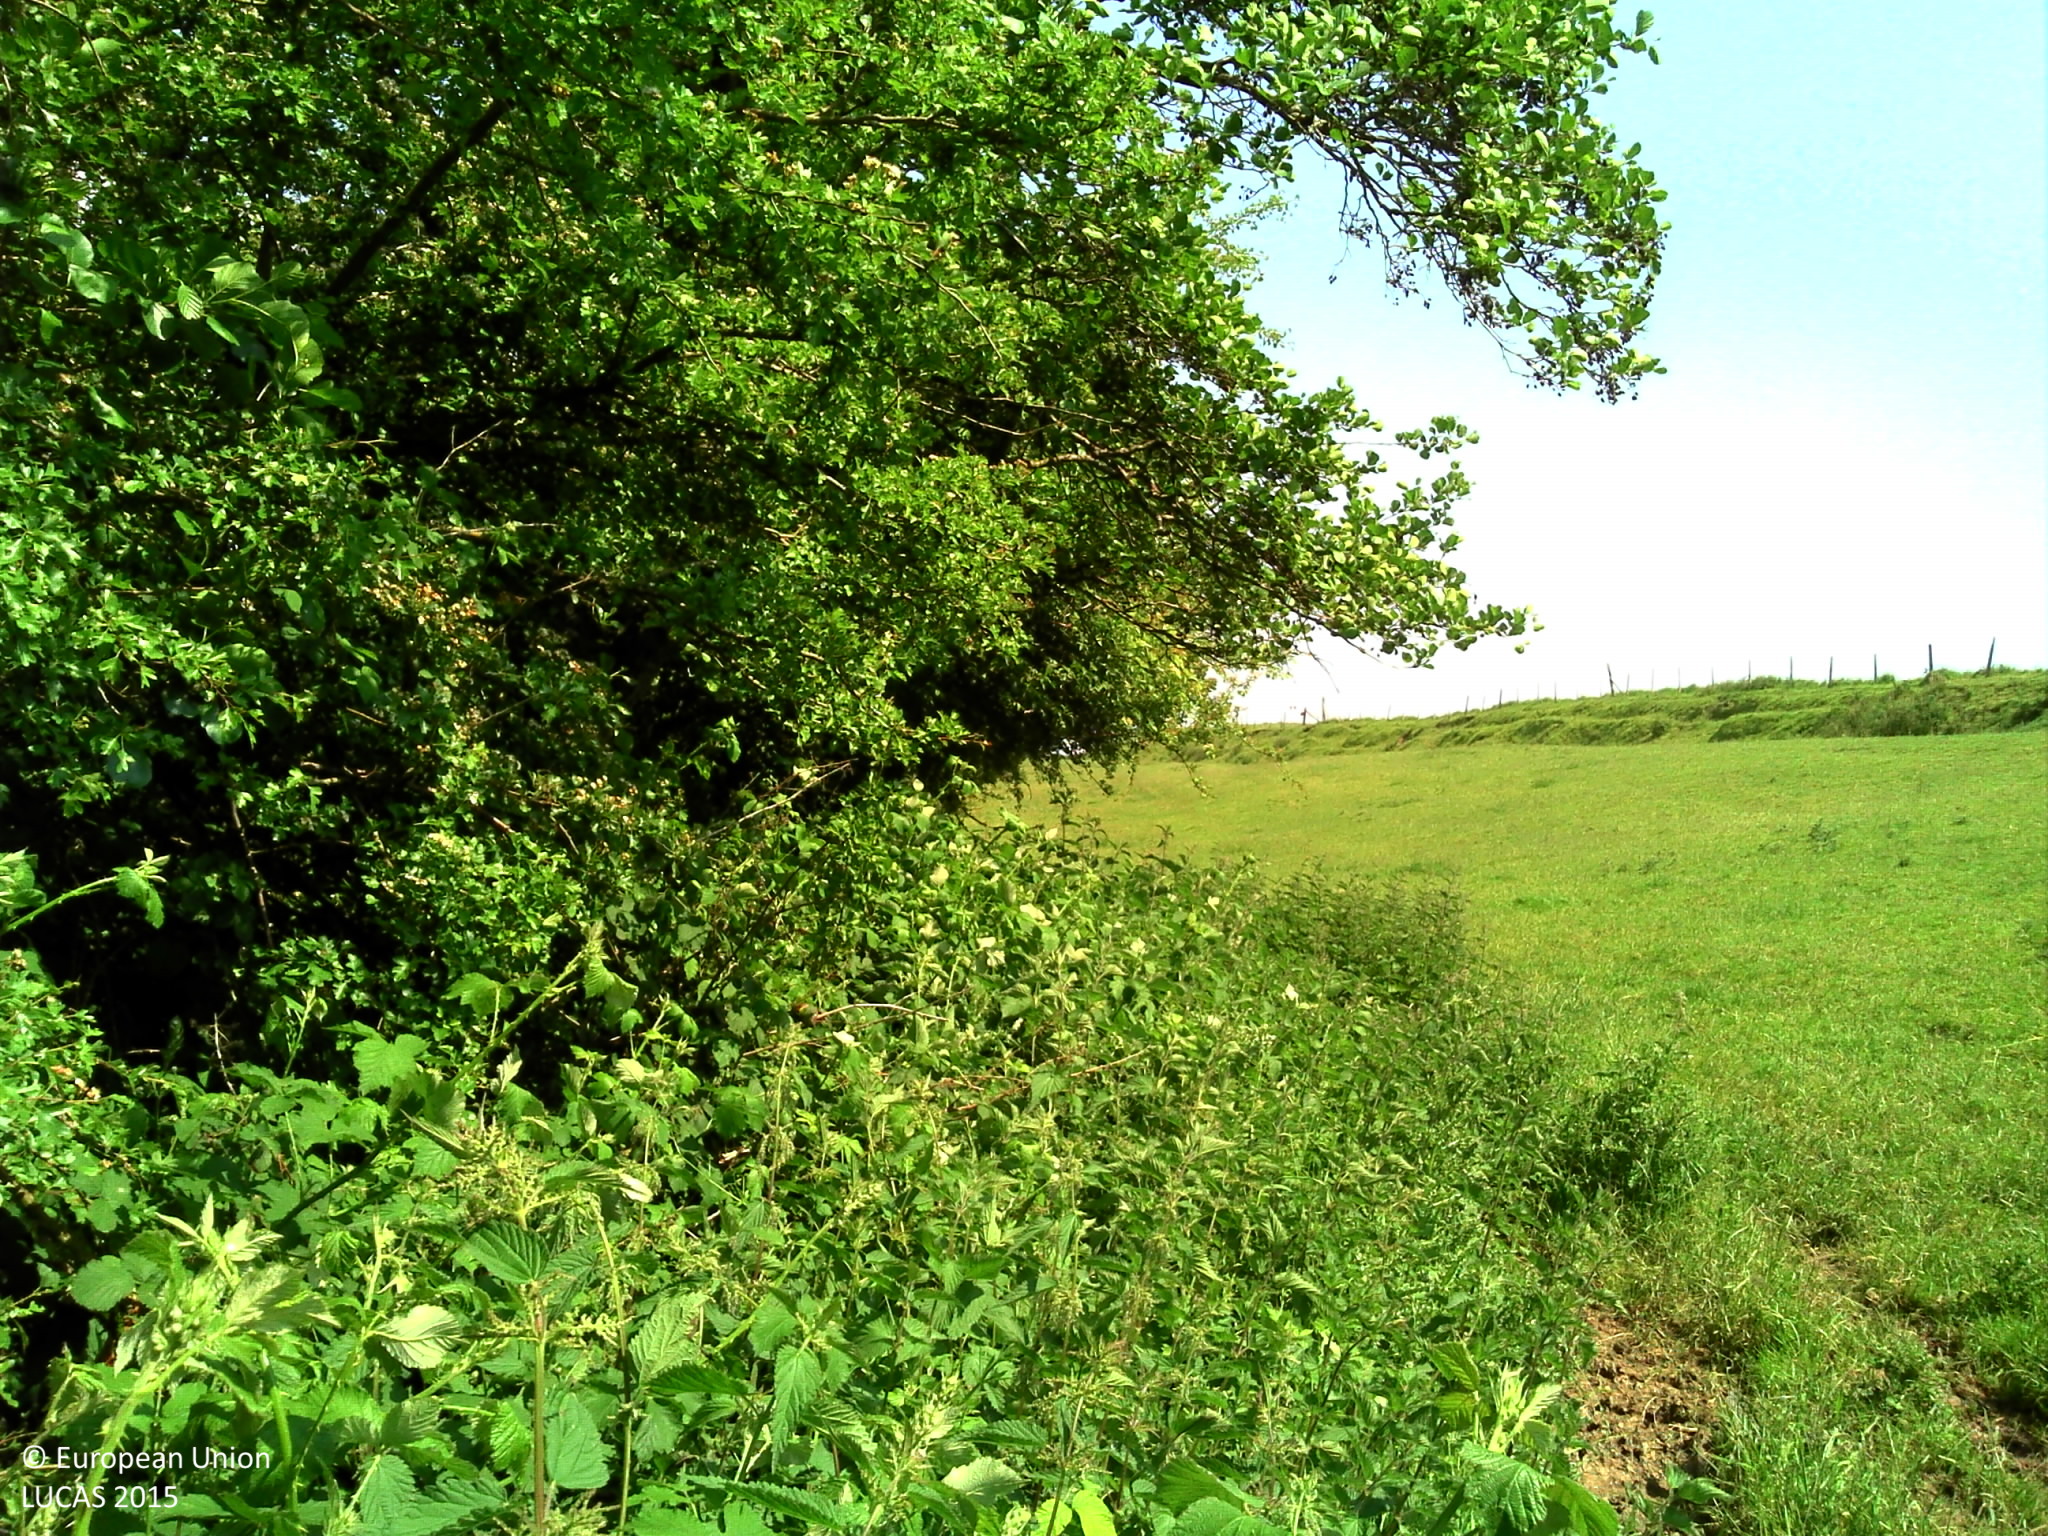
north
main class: Grassland
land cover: Grassland without tree/shrub cover
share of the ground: > 75 %
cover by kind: herbaceous plants 95 %
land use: Agriculture (excluding fallow land and kitchen gardens)
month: June
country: FR
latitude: 50.5778
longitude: 2.0909
